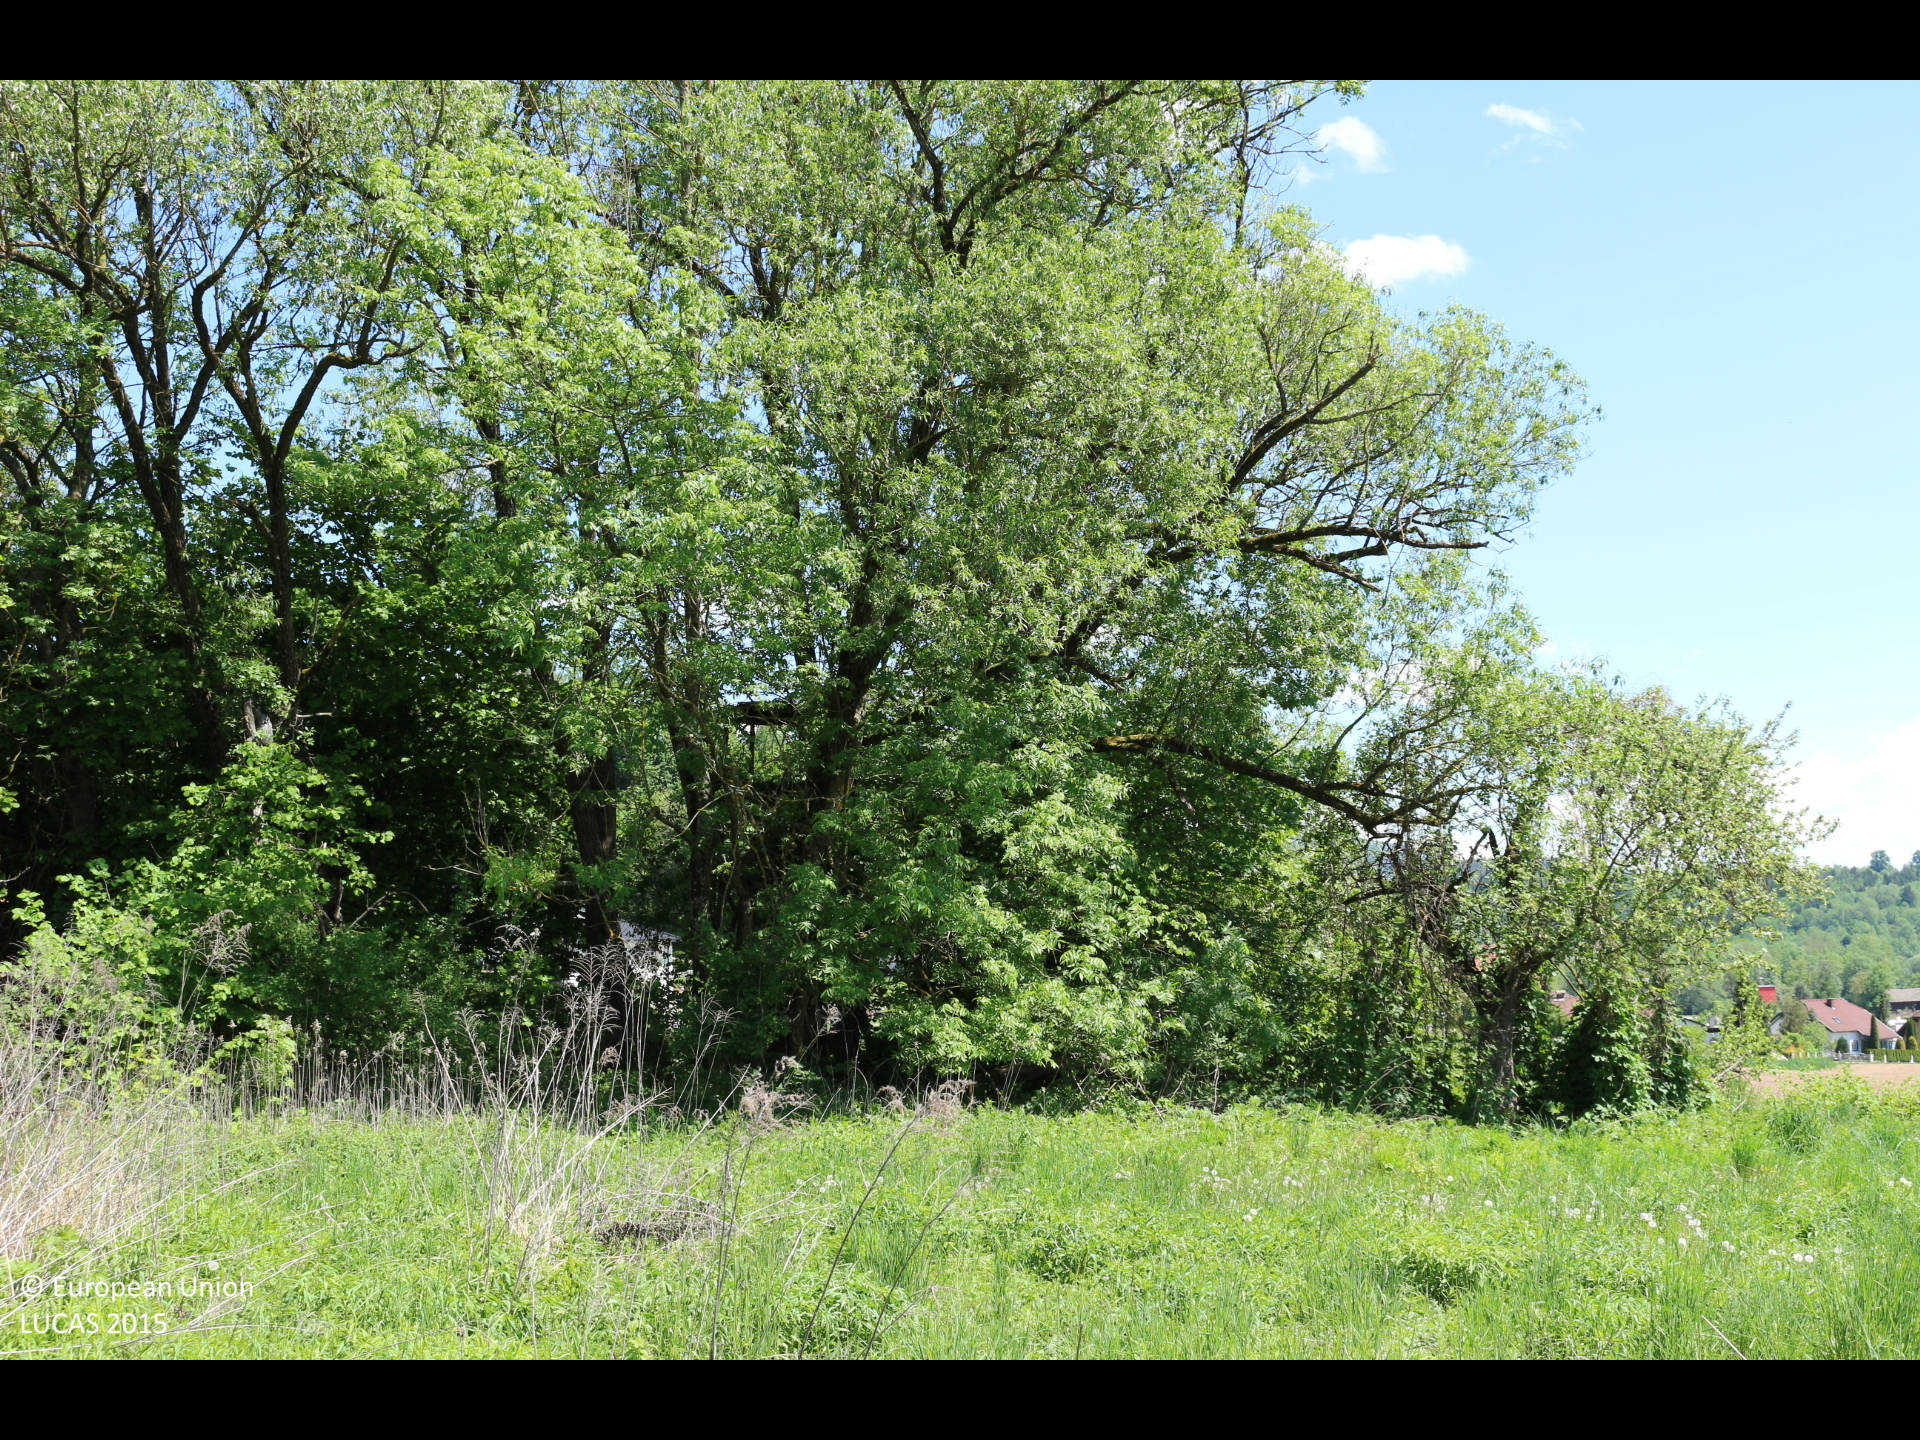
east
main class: Grassland
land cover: Spontaneously vegetated surfaces
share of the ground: > 75 %
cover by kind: herbaceous plants 95 %, shrubs 5 %
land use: Fallow land
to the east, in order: Spontaneously vegetated surfaces; Broadleaved woodland; Rye; Other bare soil; Grassland without tree/shrub cover; Artificial constructions in urban areas; Spontaneously vegetated surfaces; Artificial constructions in urban areas
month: May
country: AT
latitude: 46.6912
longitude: 14.4566
